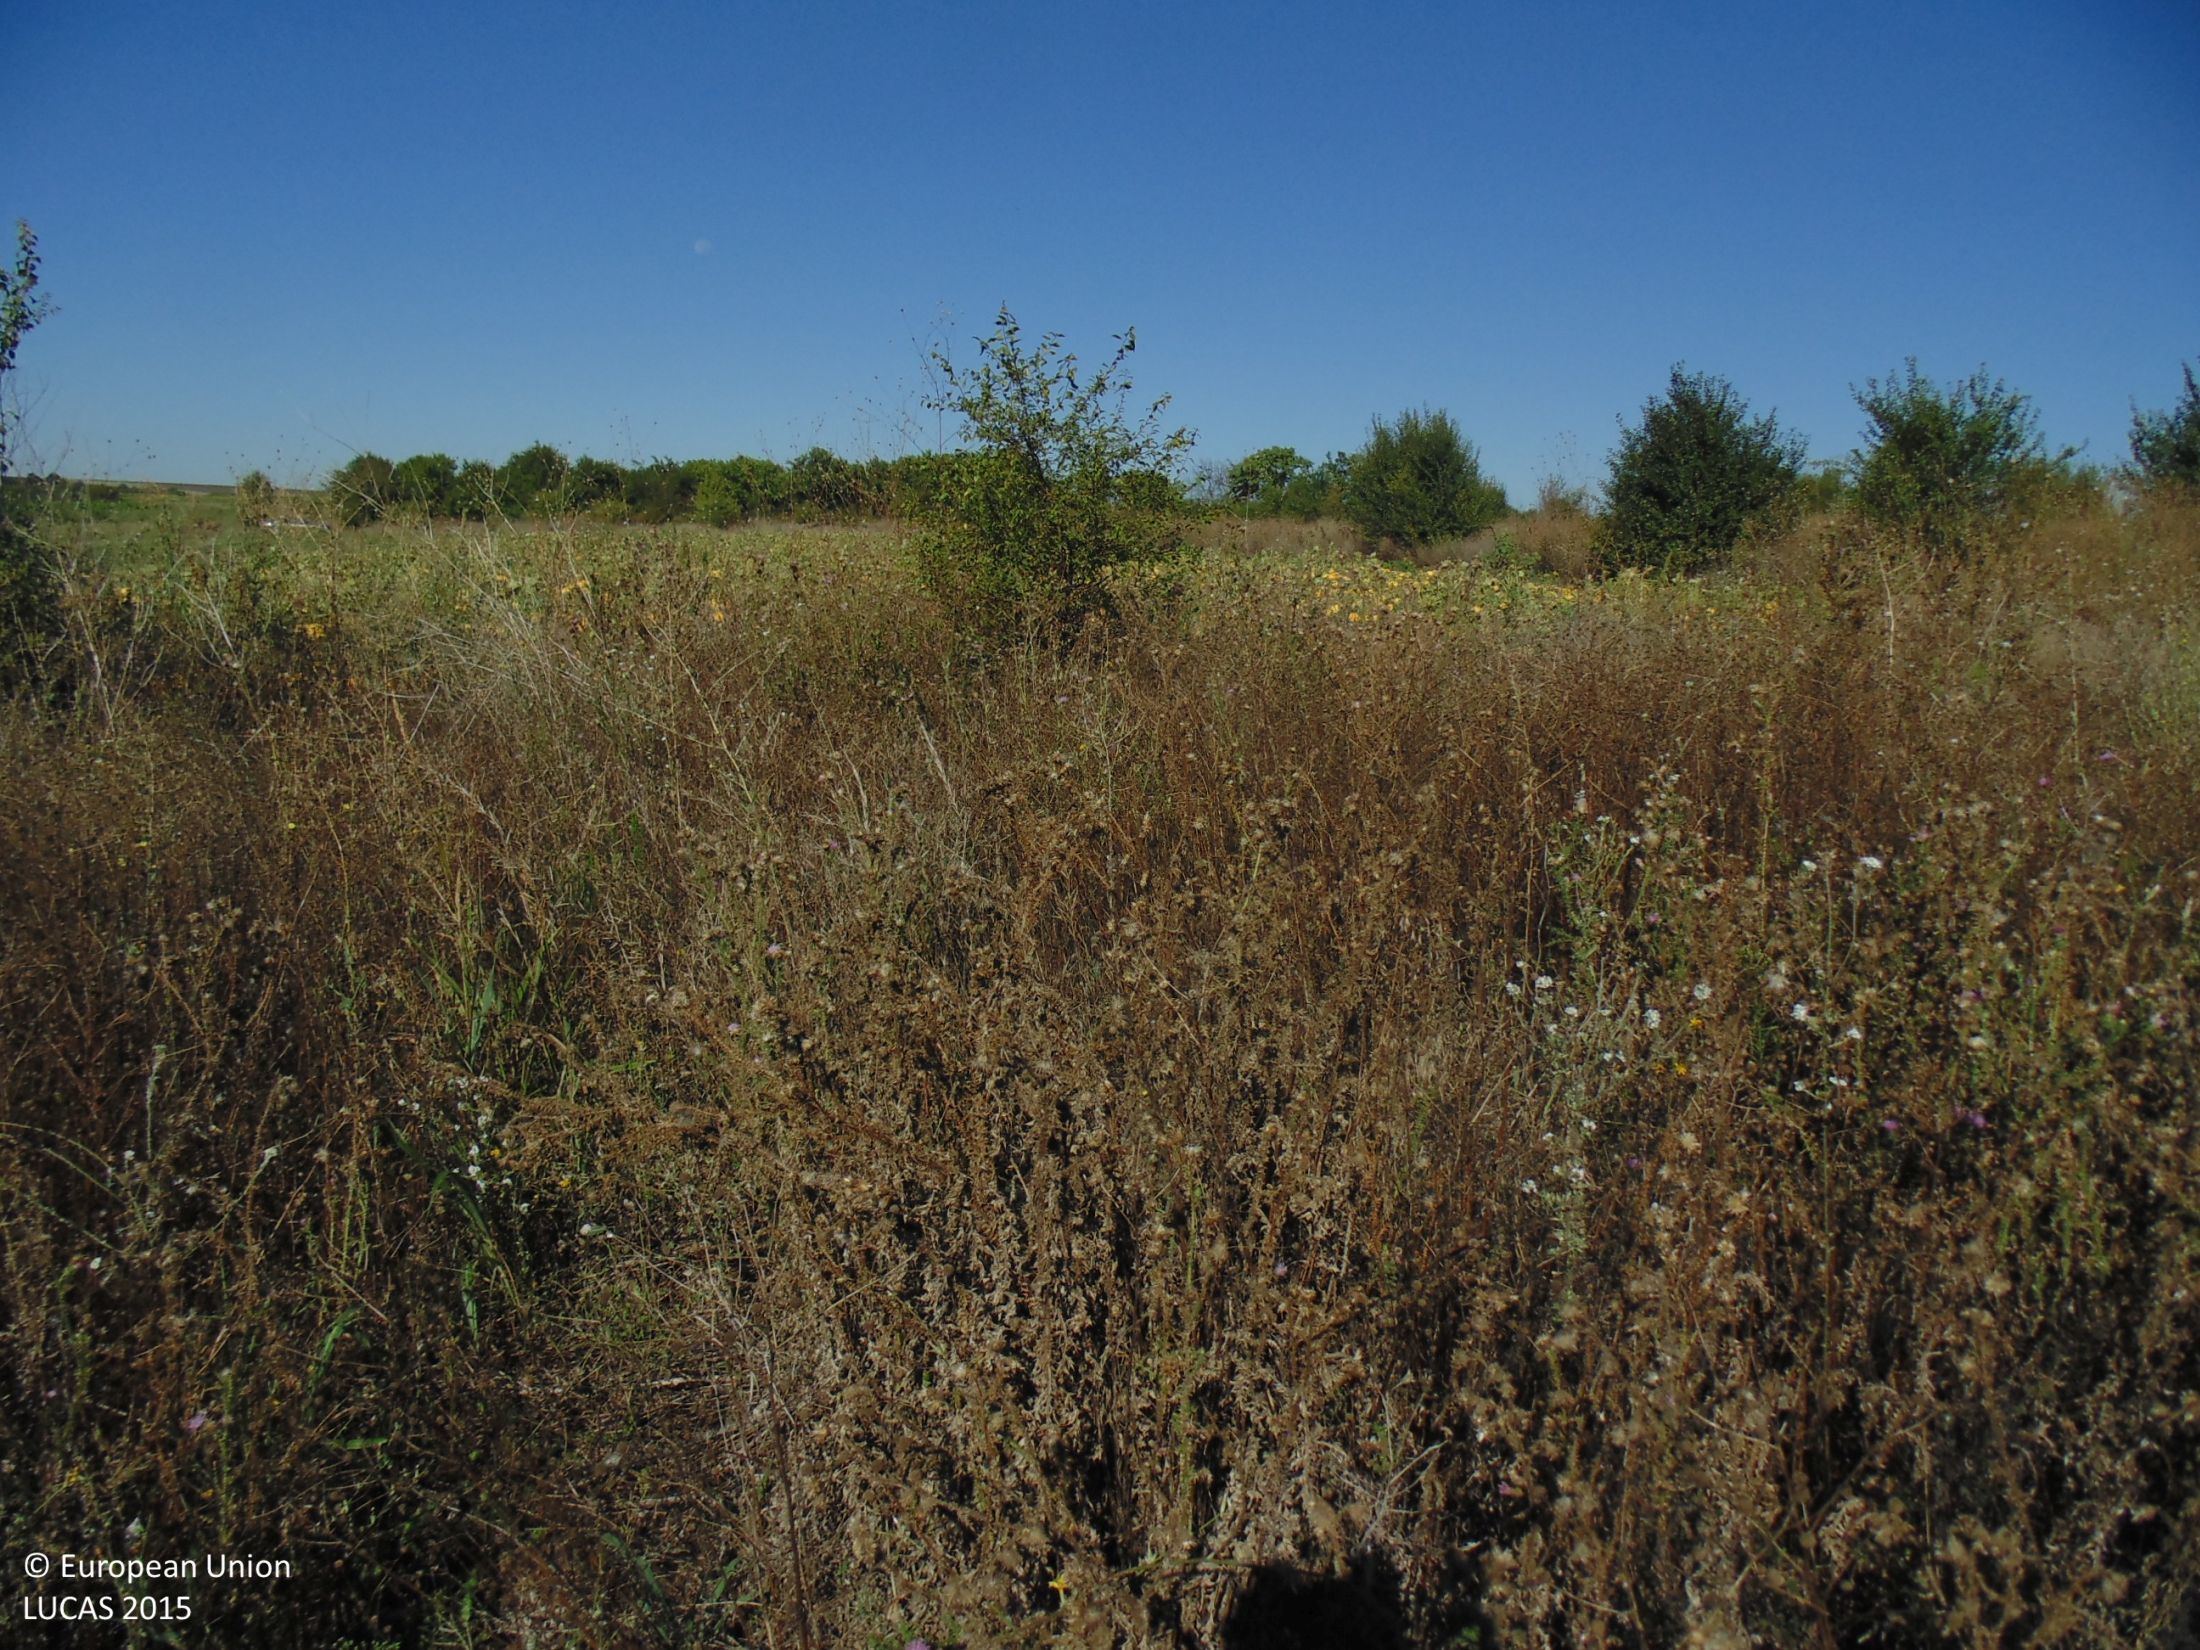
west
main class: Grassland
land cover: Grassland with sparse tree/shrub cover
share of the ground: > 75 %
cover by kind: herbaceous plants 90 %, broadleaved forest trees 5 %, shrubs 5 %
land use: Abandoned areas
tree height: < 5 m
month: September
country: BG
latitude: 43.7870
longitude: 27.1874
